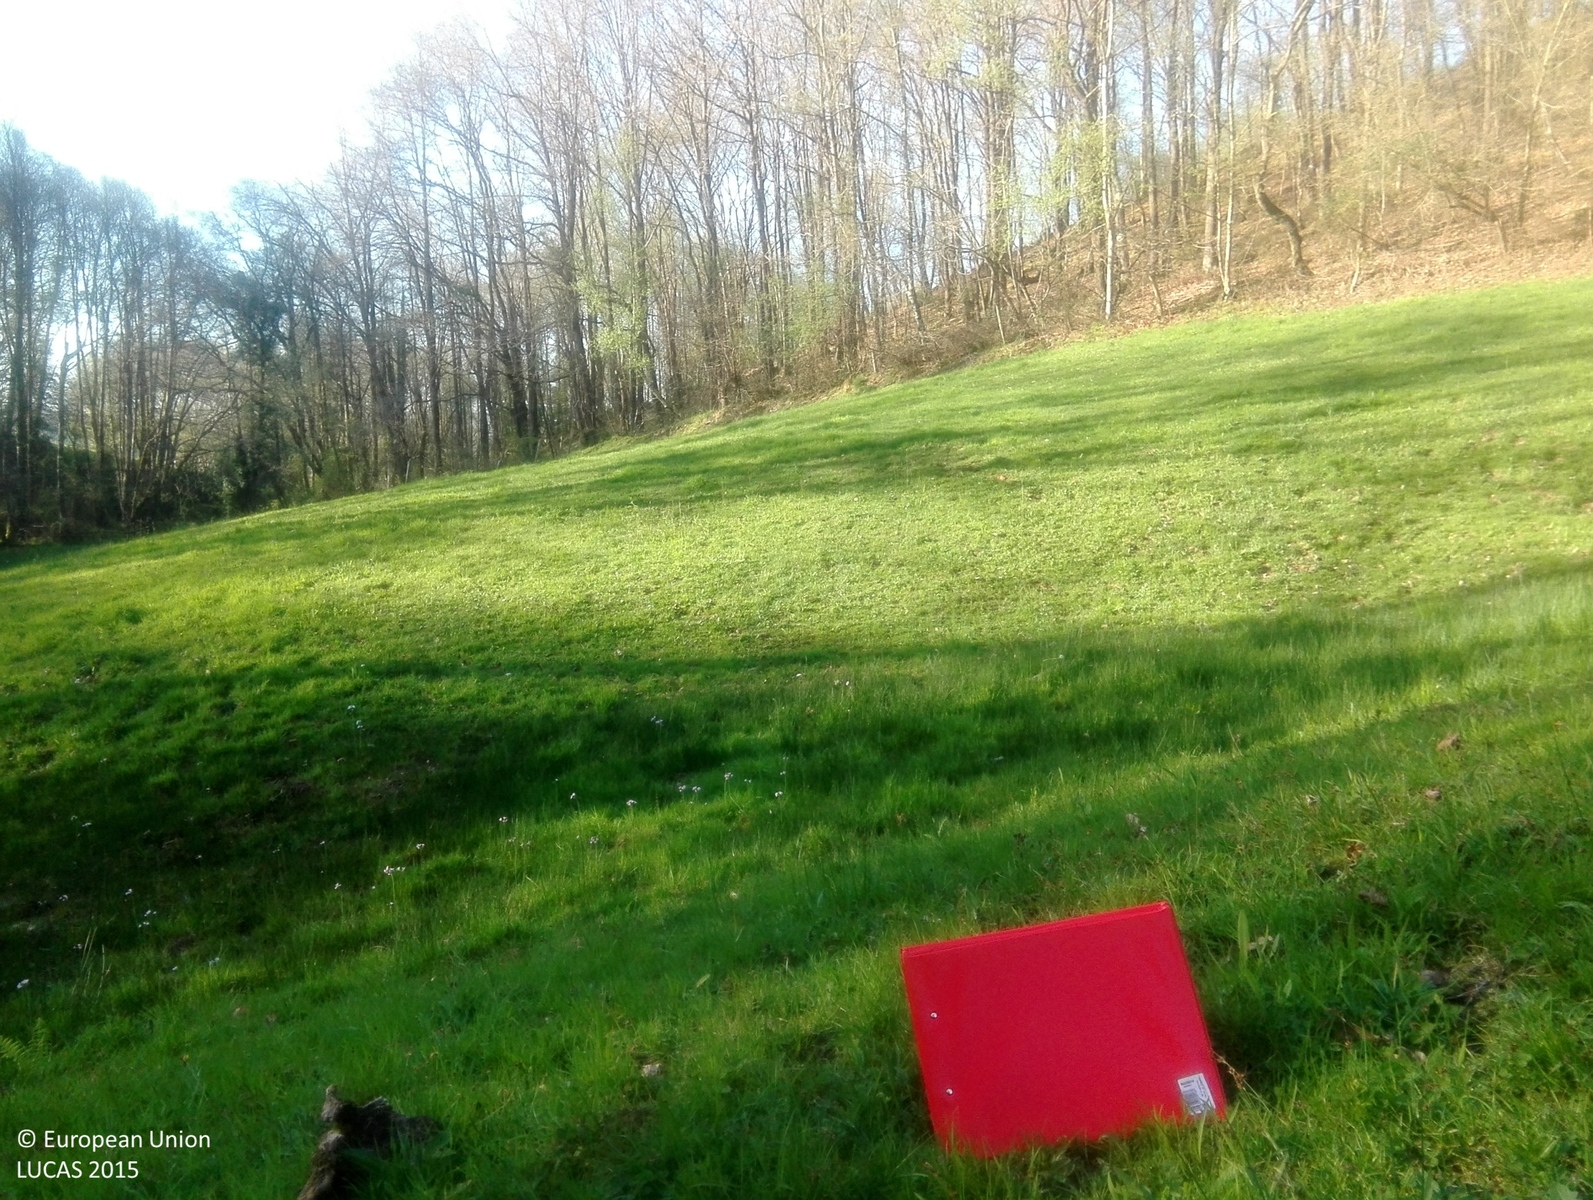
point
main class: Grassland
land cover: Grassland without tree/shrub cover
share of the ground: > 75 %
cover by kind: herbaceous plants 100 %
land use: Agriculture (excluding fallow land and kitchen gardens)
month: April
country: ES
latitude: 43.3787
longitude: -5.6225
